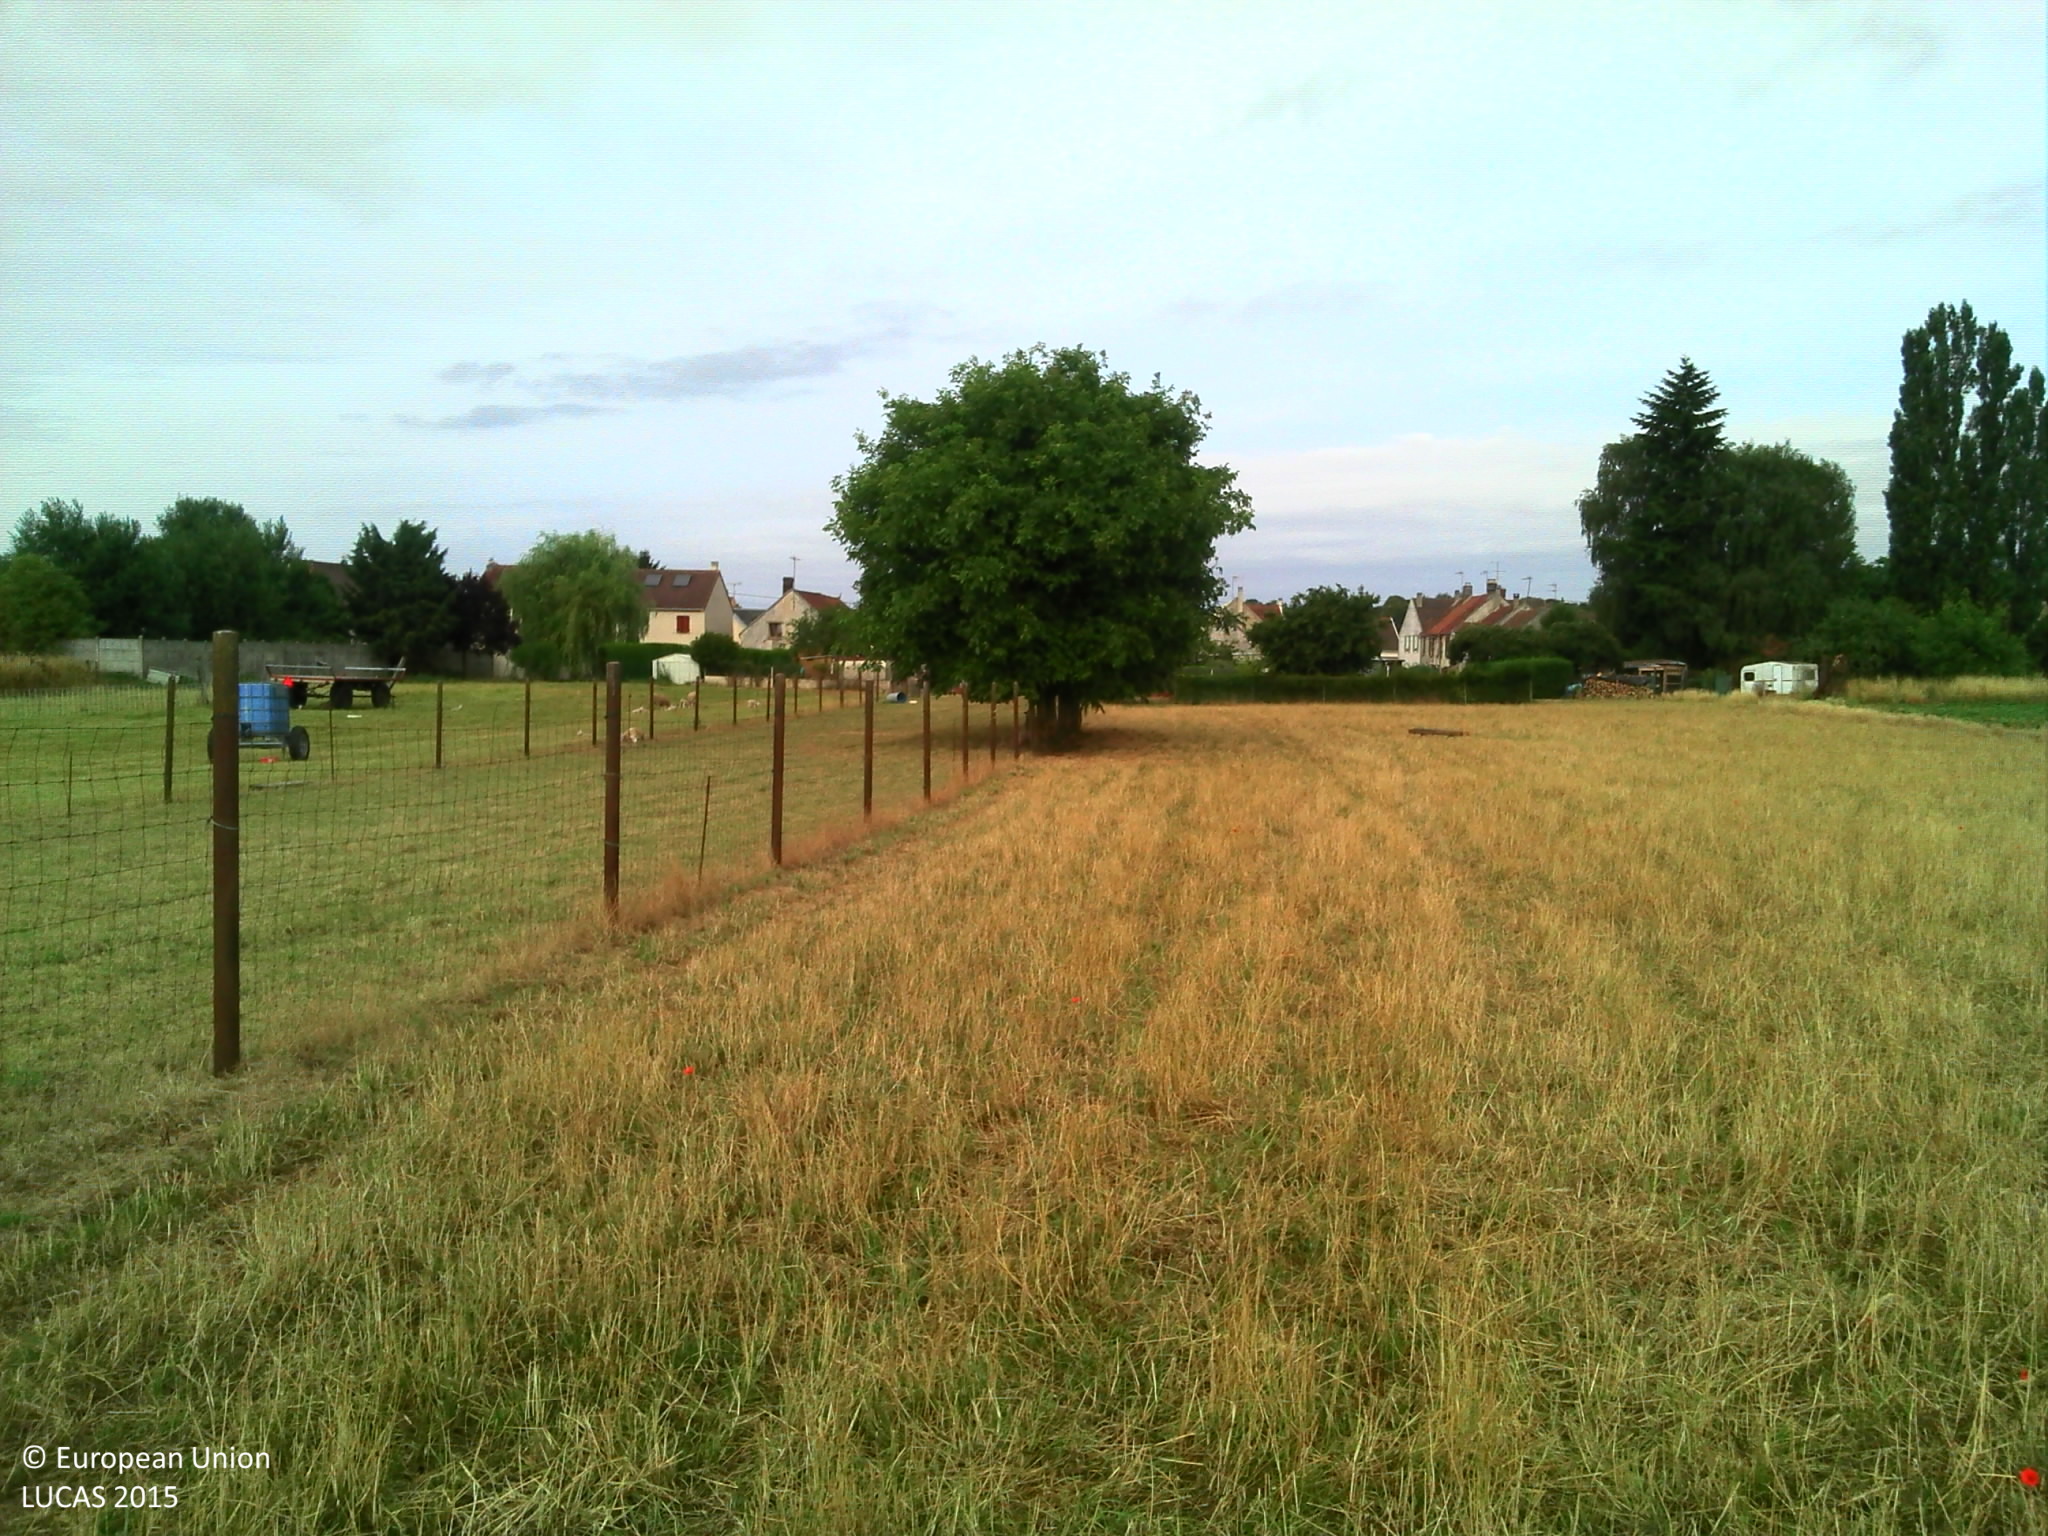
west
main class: Grassland
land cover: Grassland without tree/shrub cover
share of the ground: > 75 %
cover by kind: herbaceous plants 100 %
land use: Agriculture (excluding fallow land and kitchen gardens)
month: July
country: FR
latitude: 49.1666
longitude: 2.8723
